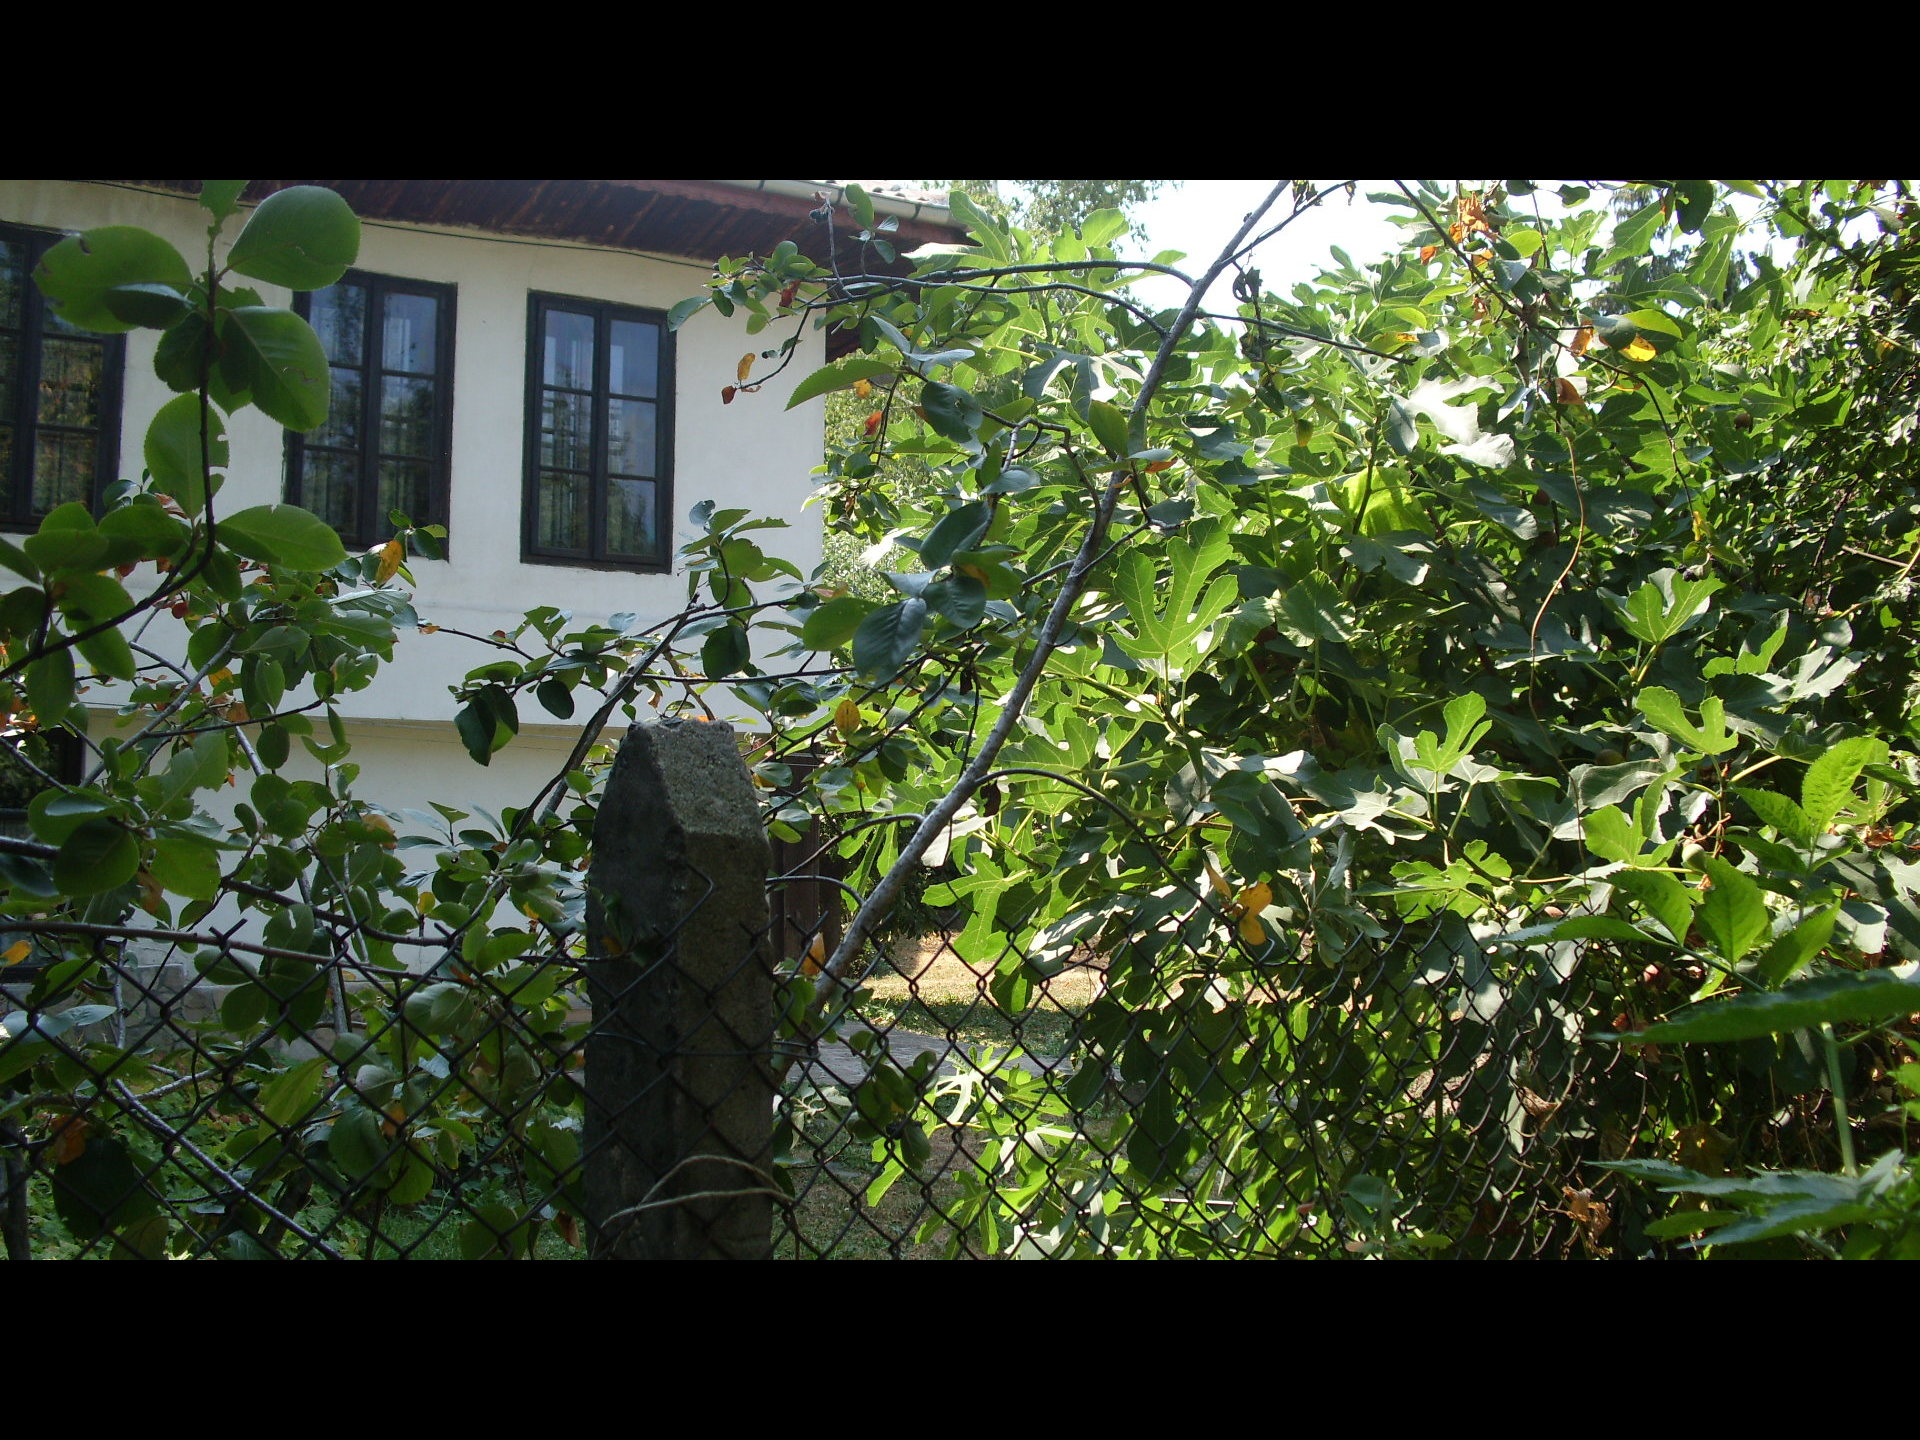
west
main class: Grassland
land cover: Grassland with sparse tree/shrub cover
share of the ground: > 75 %
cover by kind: herbaceous plants 85 %, shrubs 10 %, broadleaved forest trees 5 %
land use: Residential
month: August
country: BG
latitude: 43.2387
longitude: 23.1270
